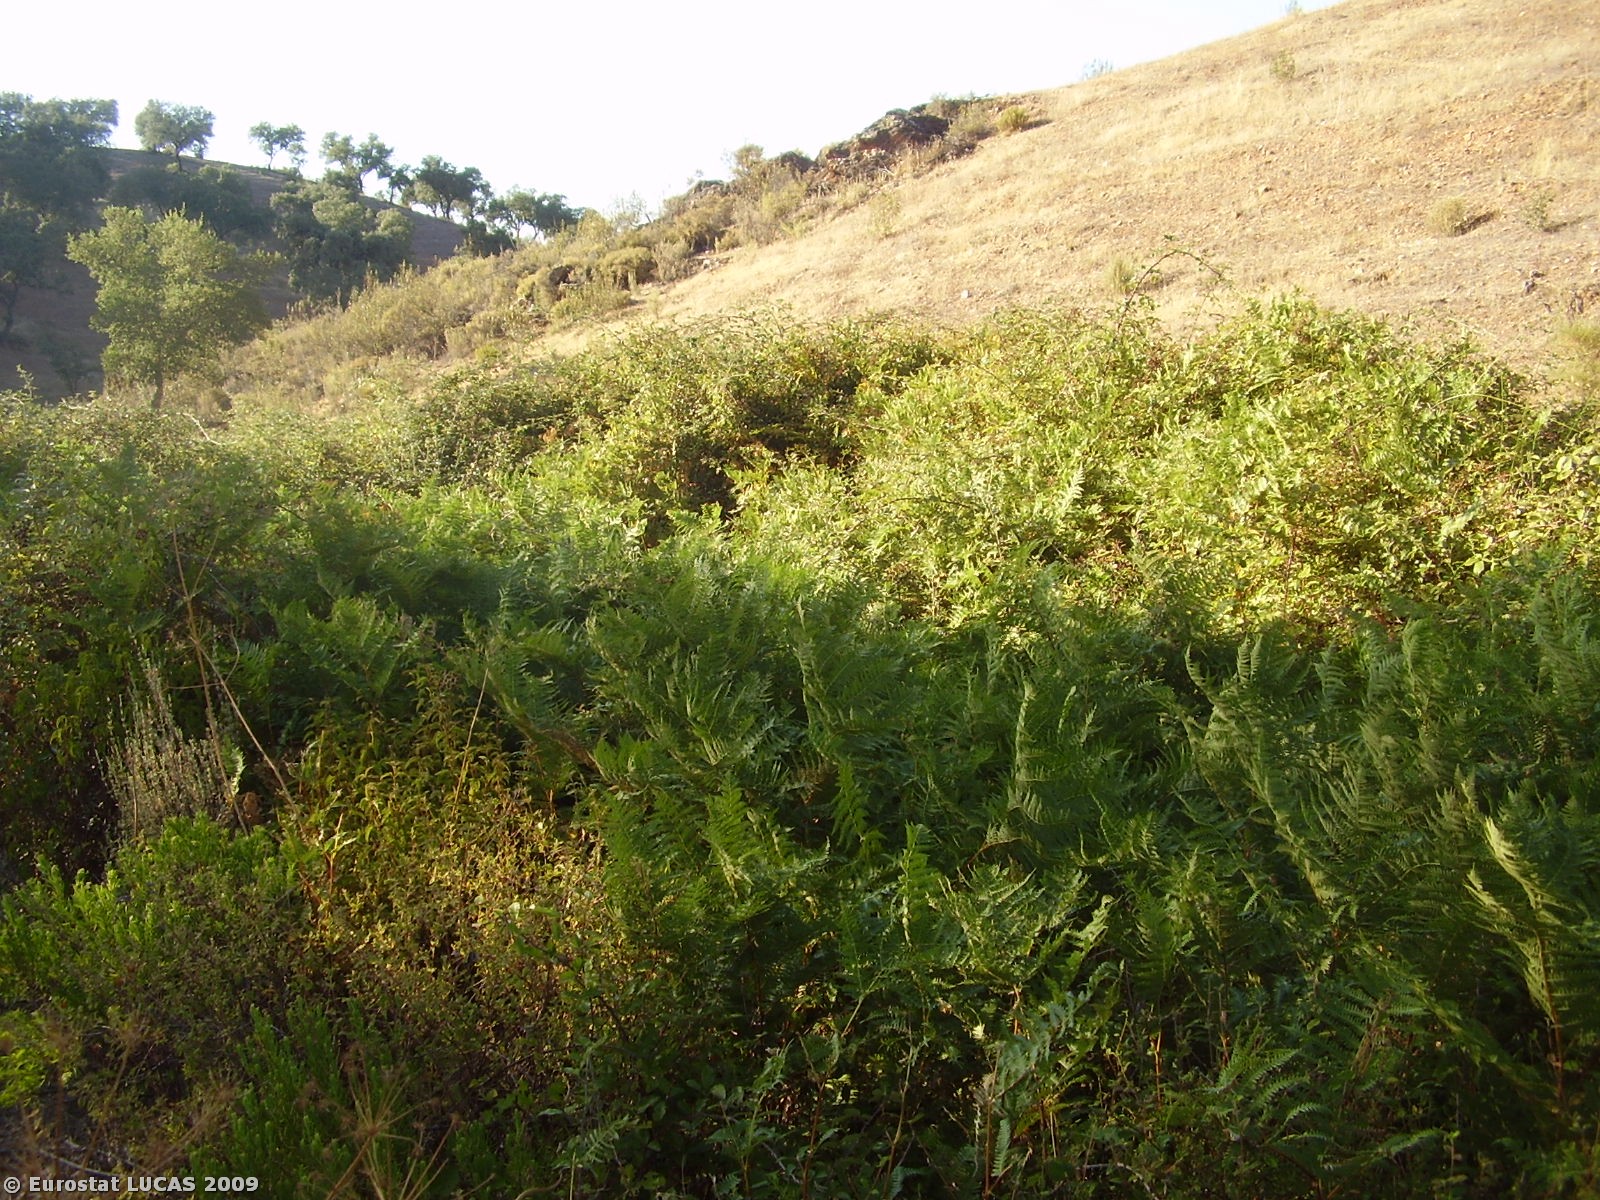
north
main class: Shrubland
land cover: Shrubland without tree cover
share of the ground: > 75 %
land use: Fallow land
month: July
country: PT
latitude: 37.8616
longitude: -7.5331
